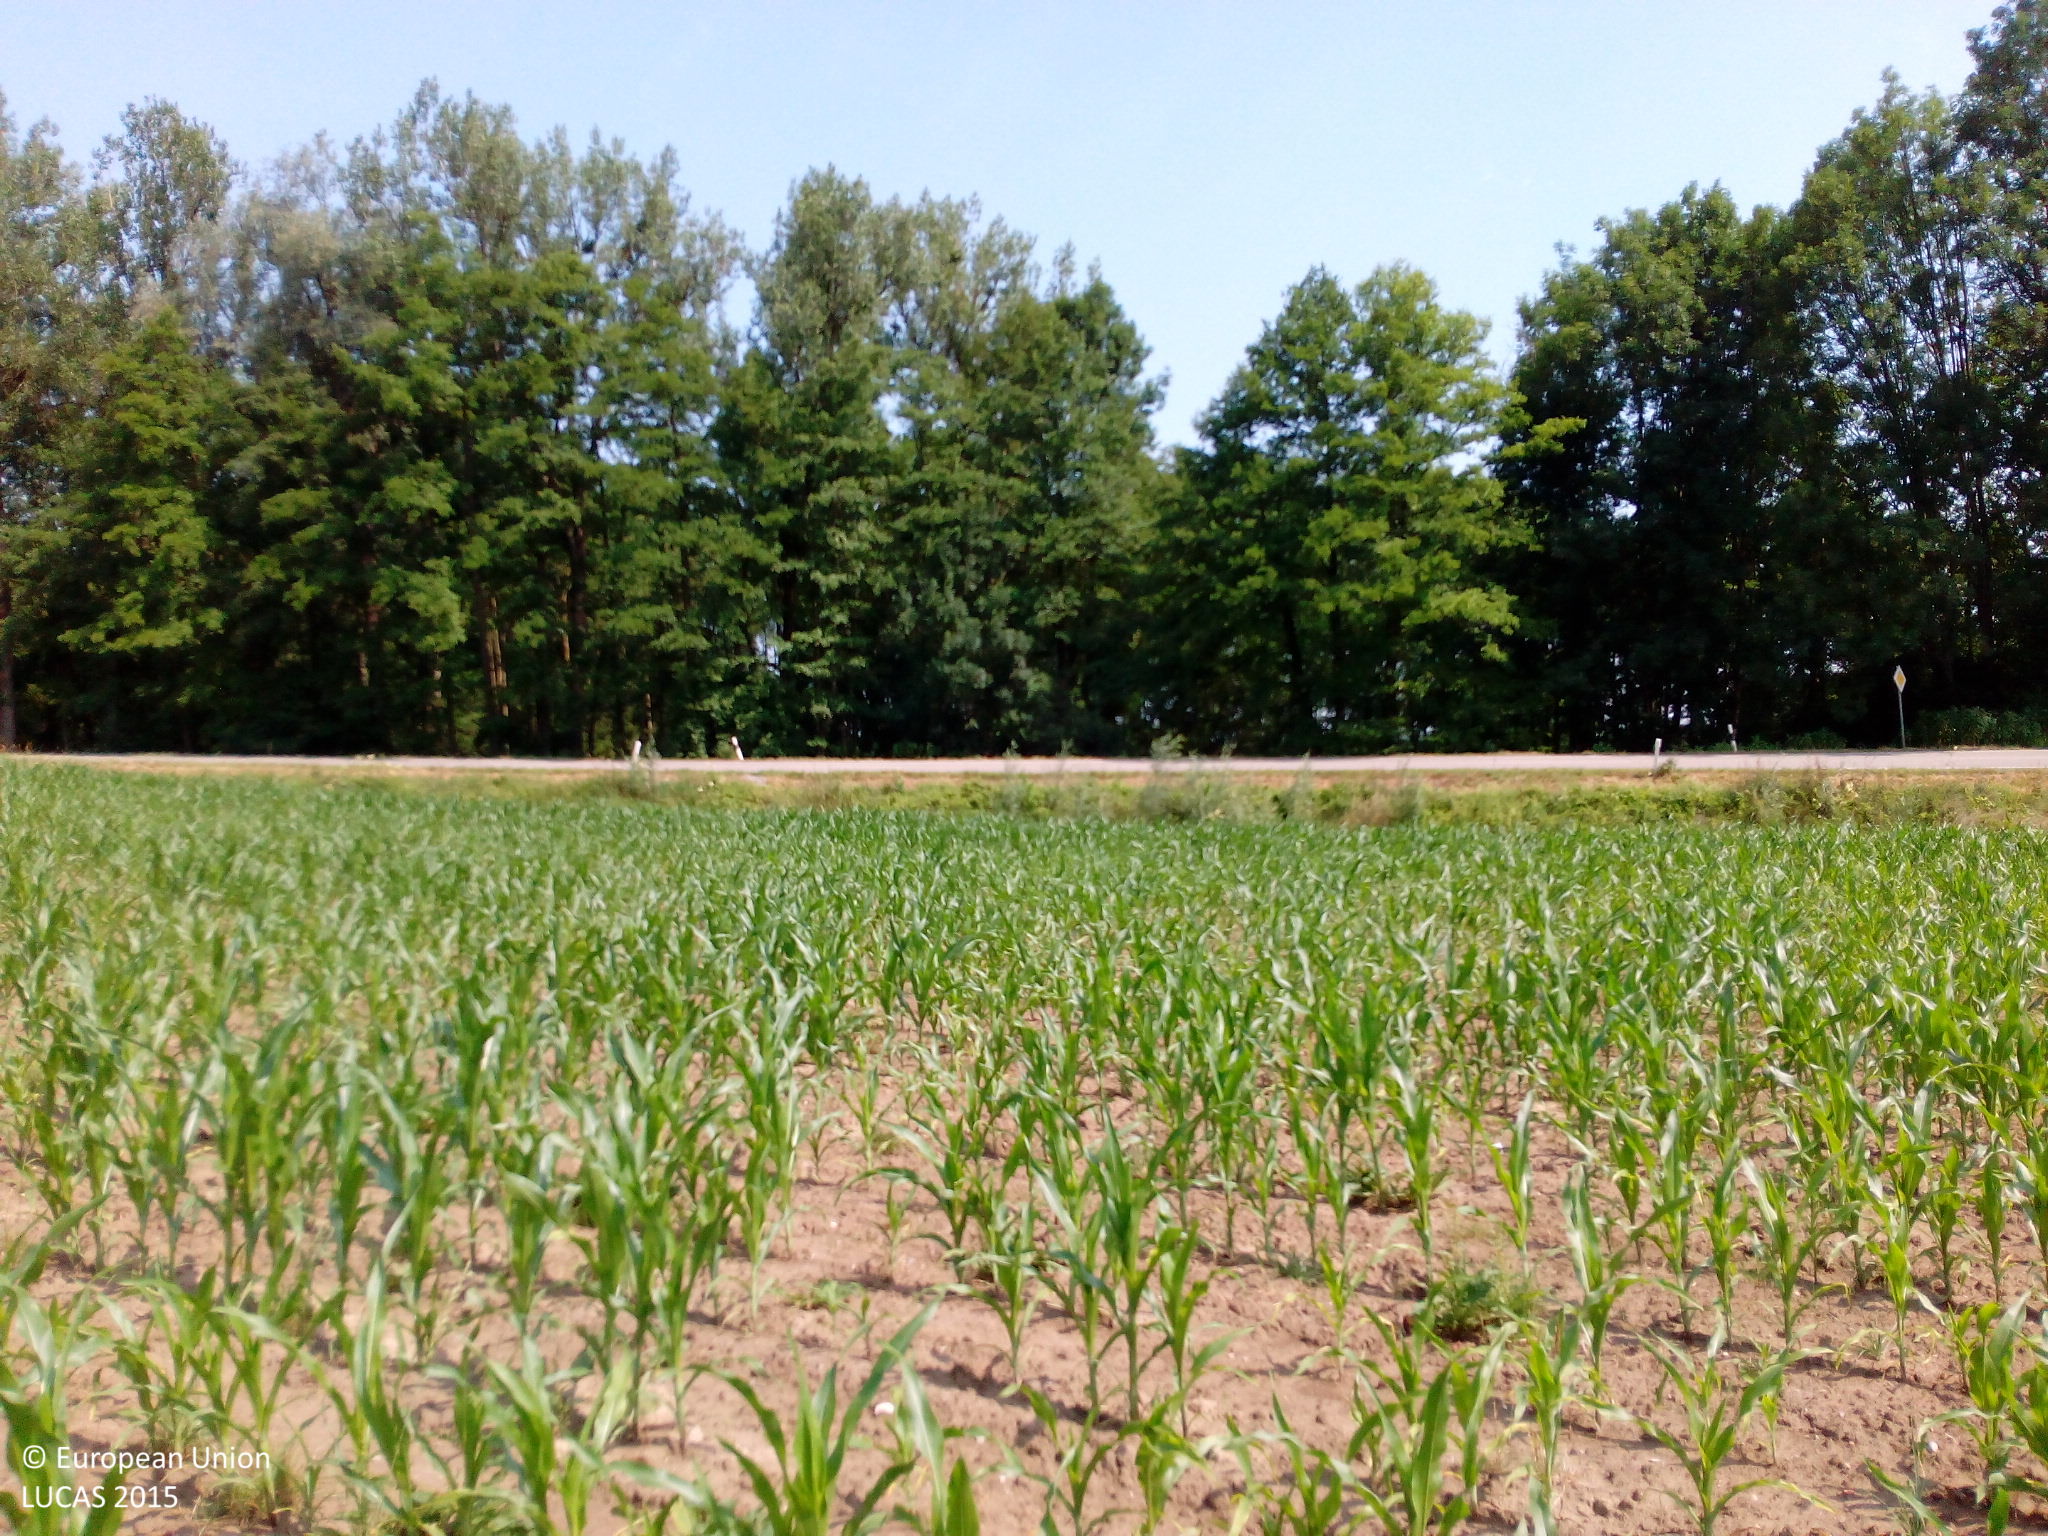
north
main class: Cropland
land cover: Maize
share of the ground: 50 - 75 %
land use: Agriculture (excluding fallow land and kitchen gardens)
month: July
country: DE
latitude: 47.8975
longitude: 12.0988
